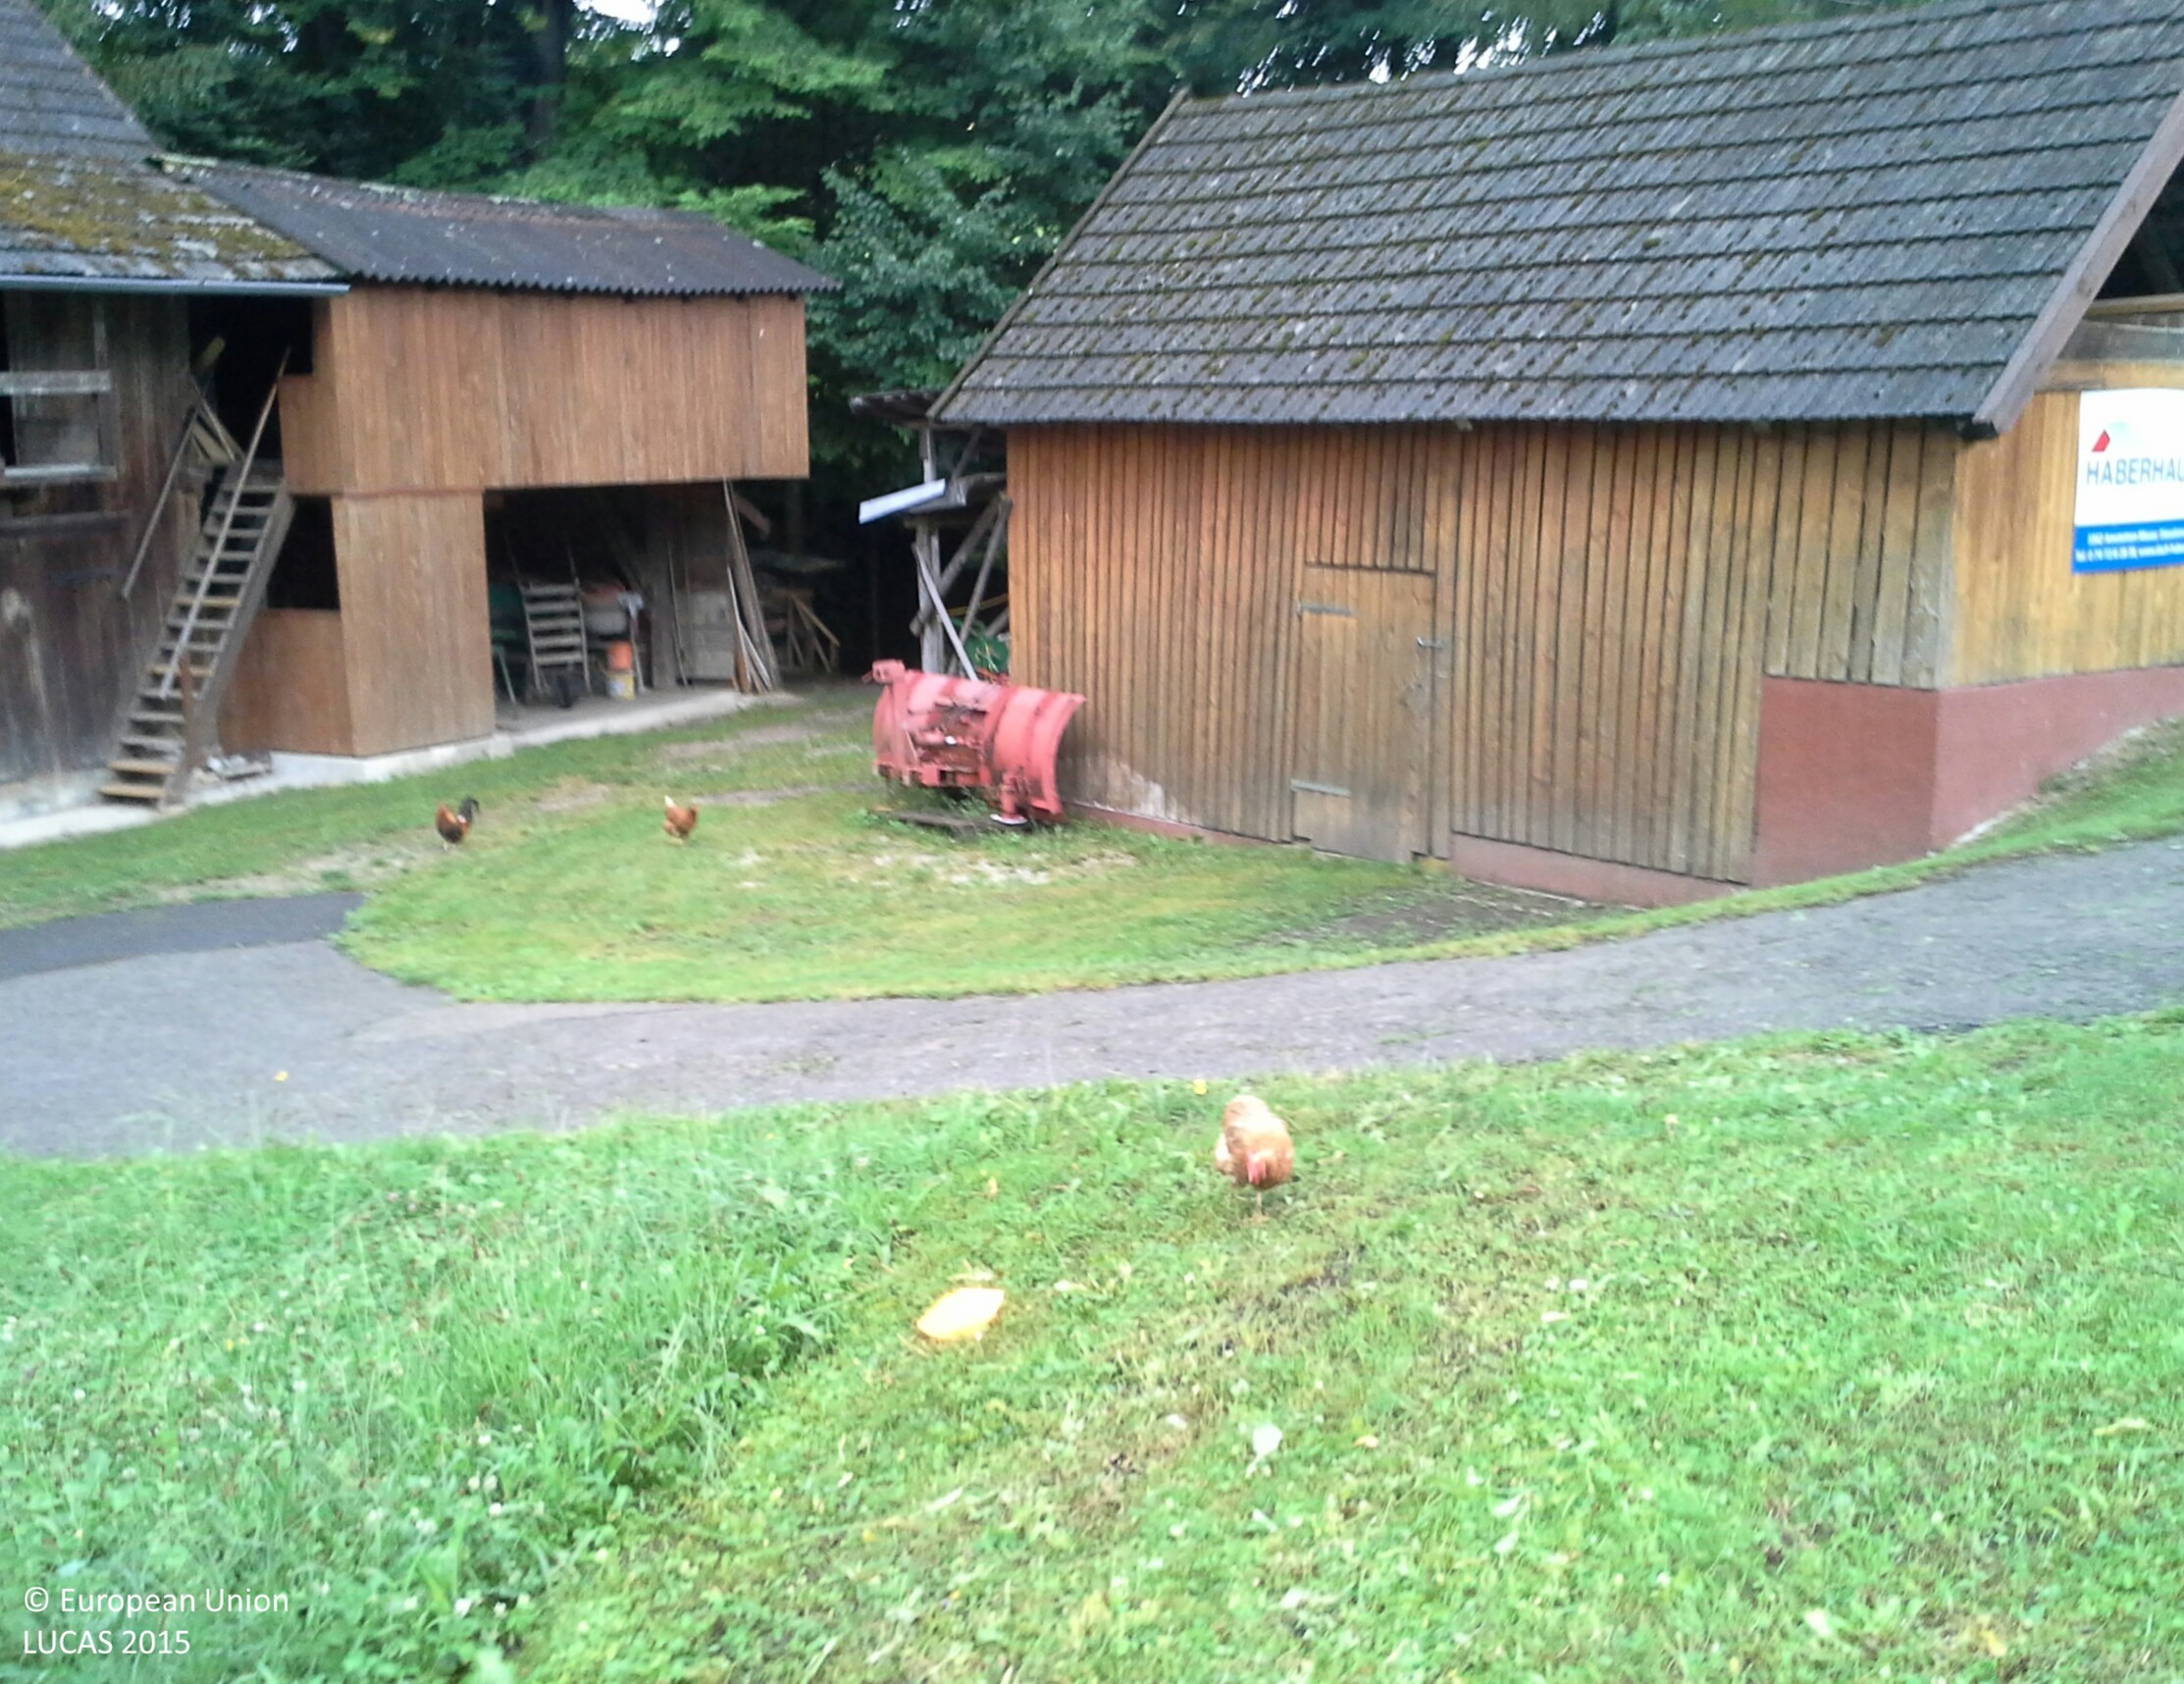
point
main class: Grassland
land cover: Grassland without tree/shrub cover
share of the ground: > 75 %
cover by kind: herbaceous plants 100 %
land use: Agriculture (excluding fallow land and kitchen gardens)
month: July
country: AT
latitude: 48.0271
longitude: 14.8415
